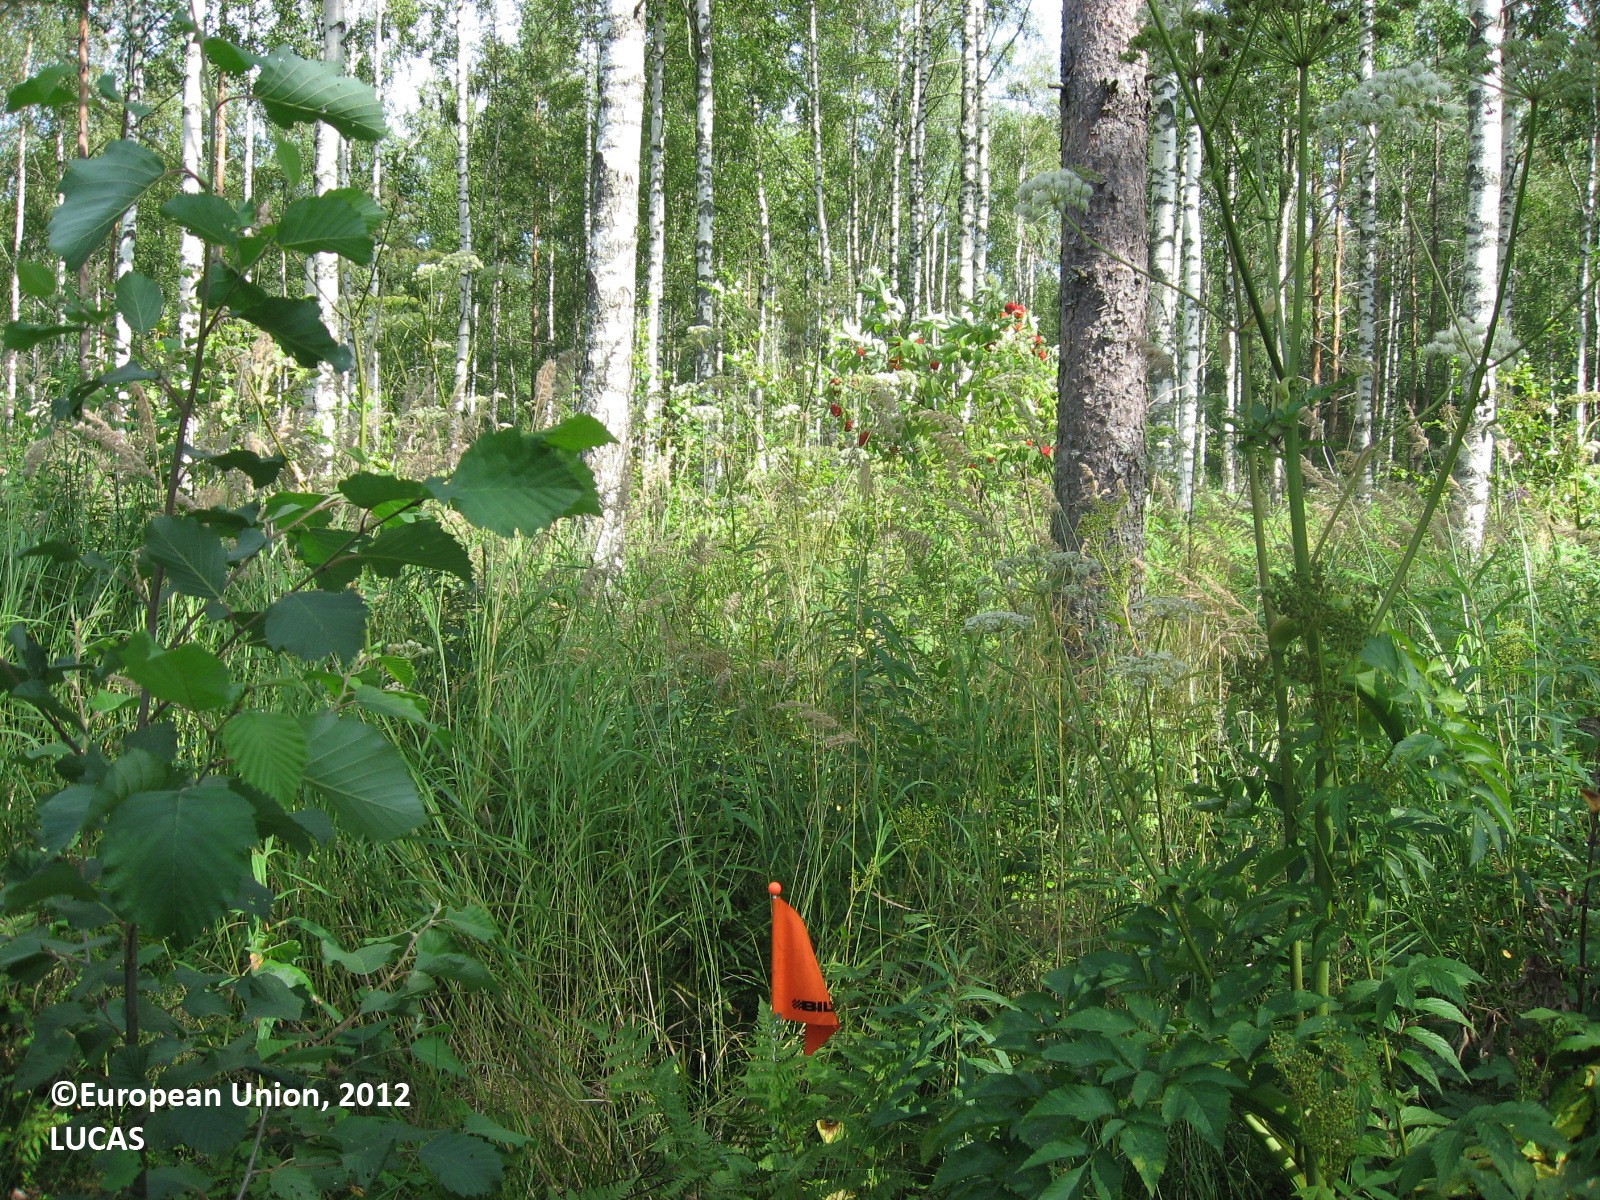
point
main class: Woodland
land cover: Broadleaved woodland
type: boreal forest
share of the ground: > 75 %
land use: Forestry
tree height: > 5 m
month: August
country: FI
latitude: 61.5416
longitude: 26.0302
